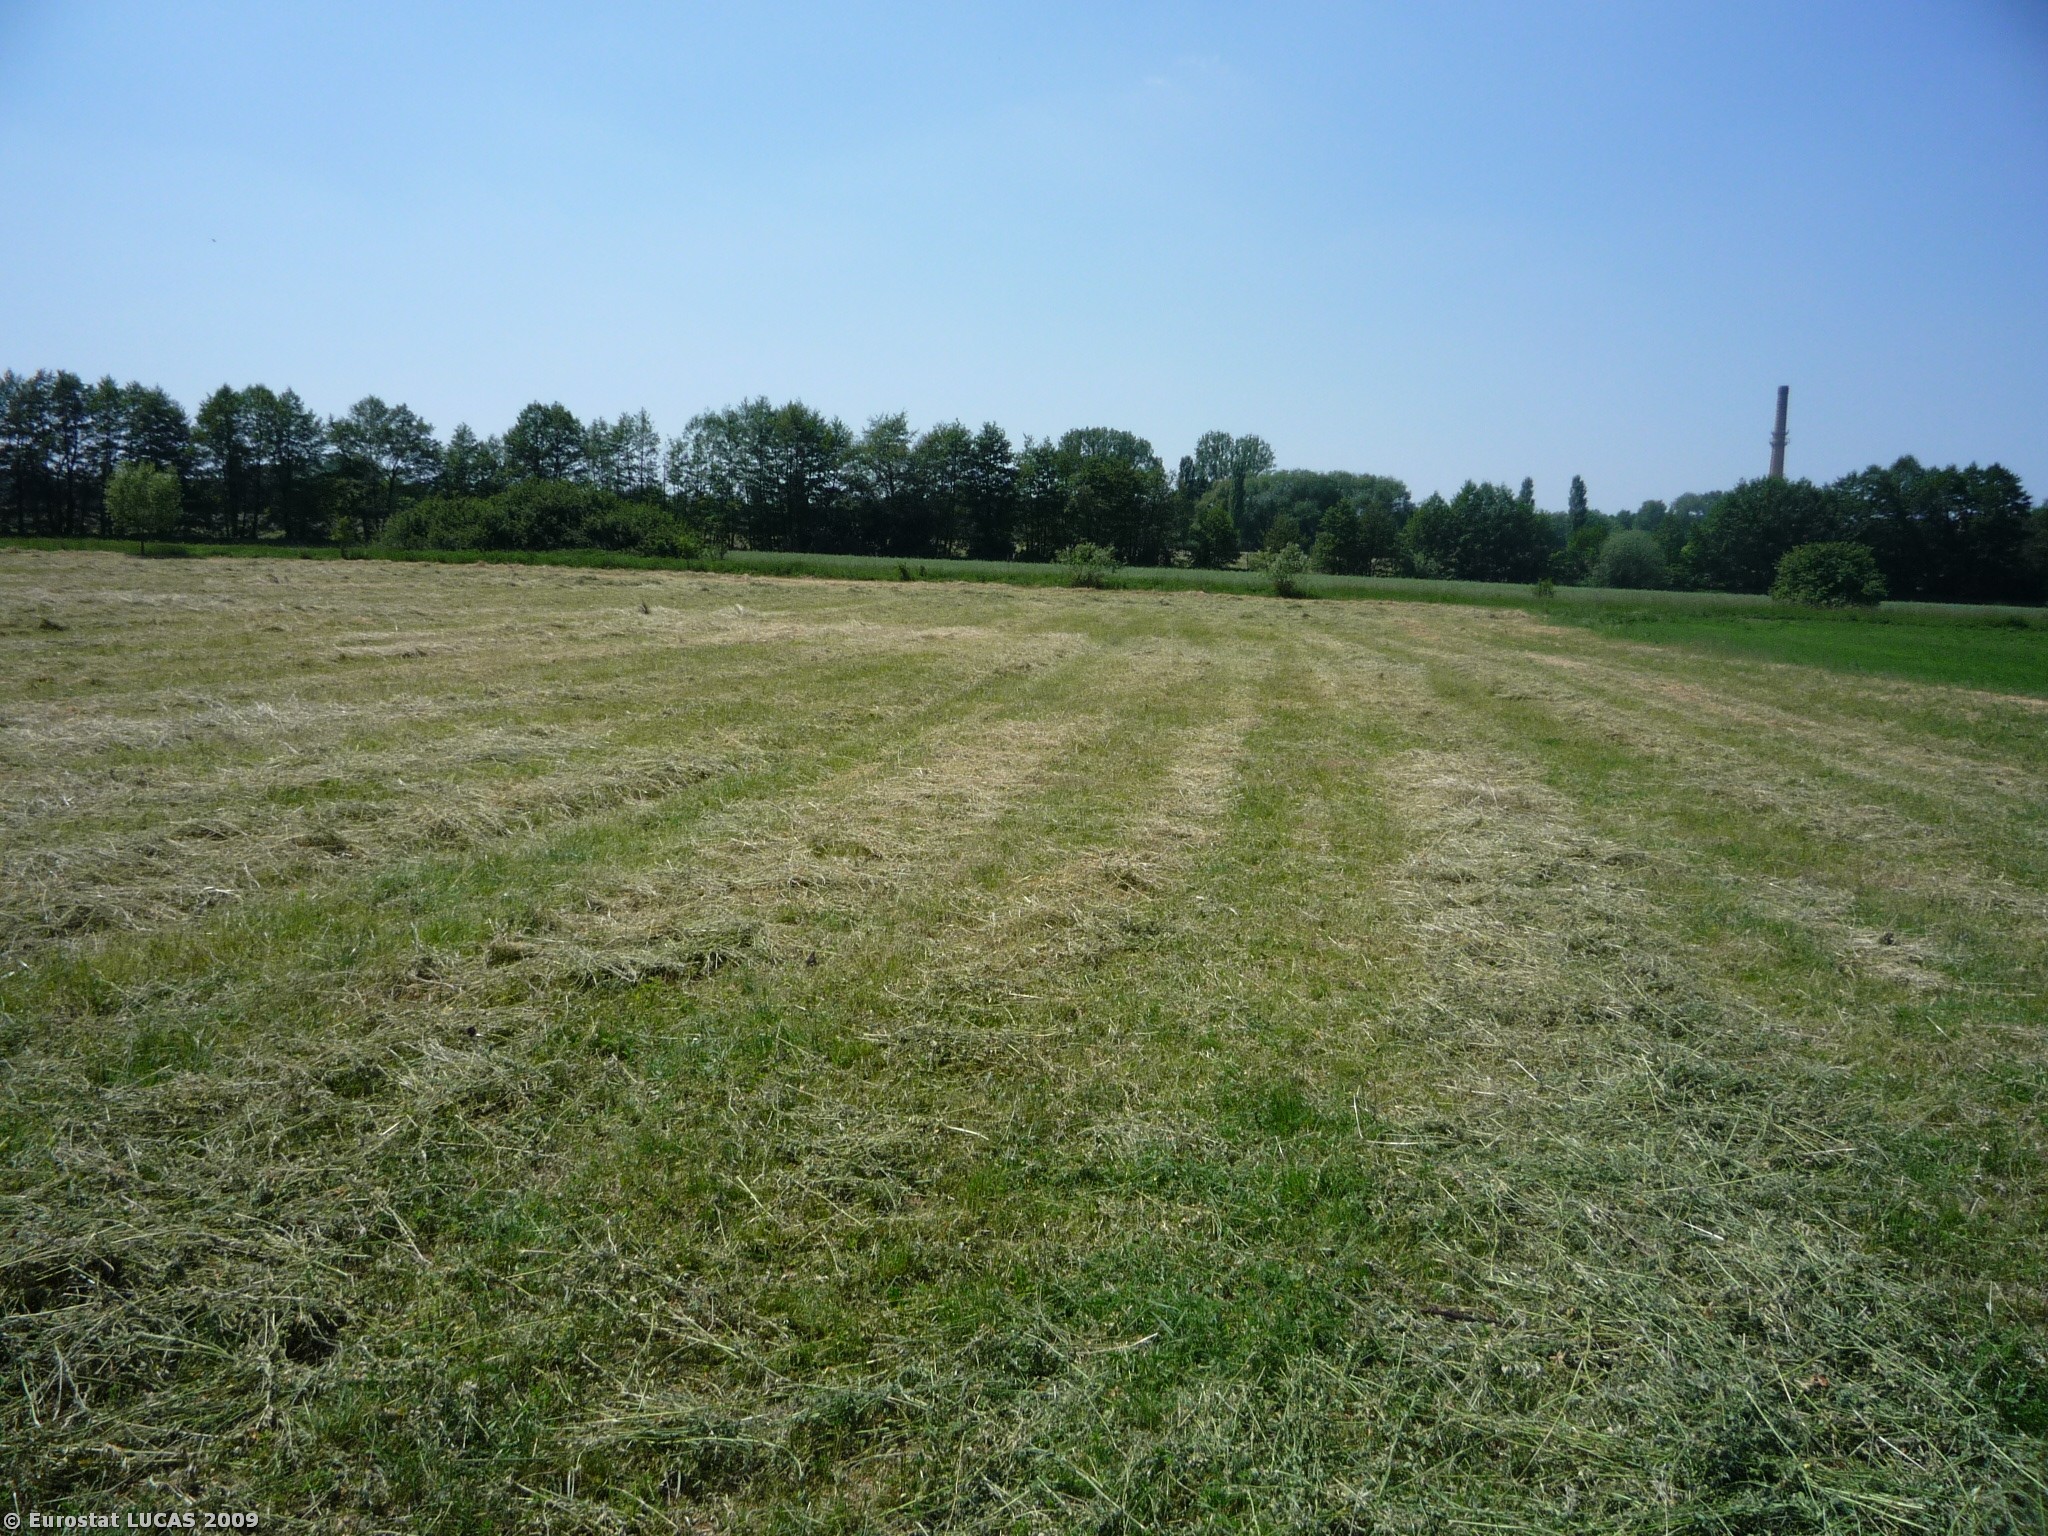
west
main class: Cropland
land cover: Lucerne
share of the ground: > 75 %
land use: Agriculture (excluding fallow land and kitchen gardens)
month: May
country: CZ
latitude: 50.2670
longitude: 15.5176
